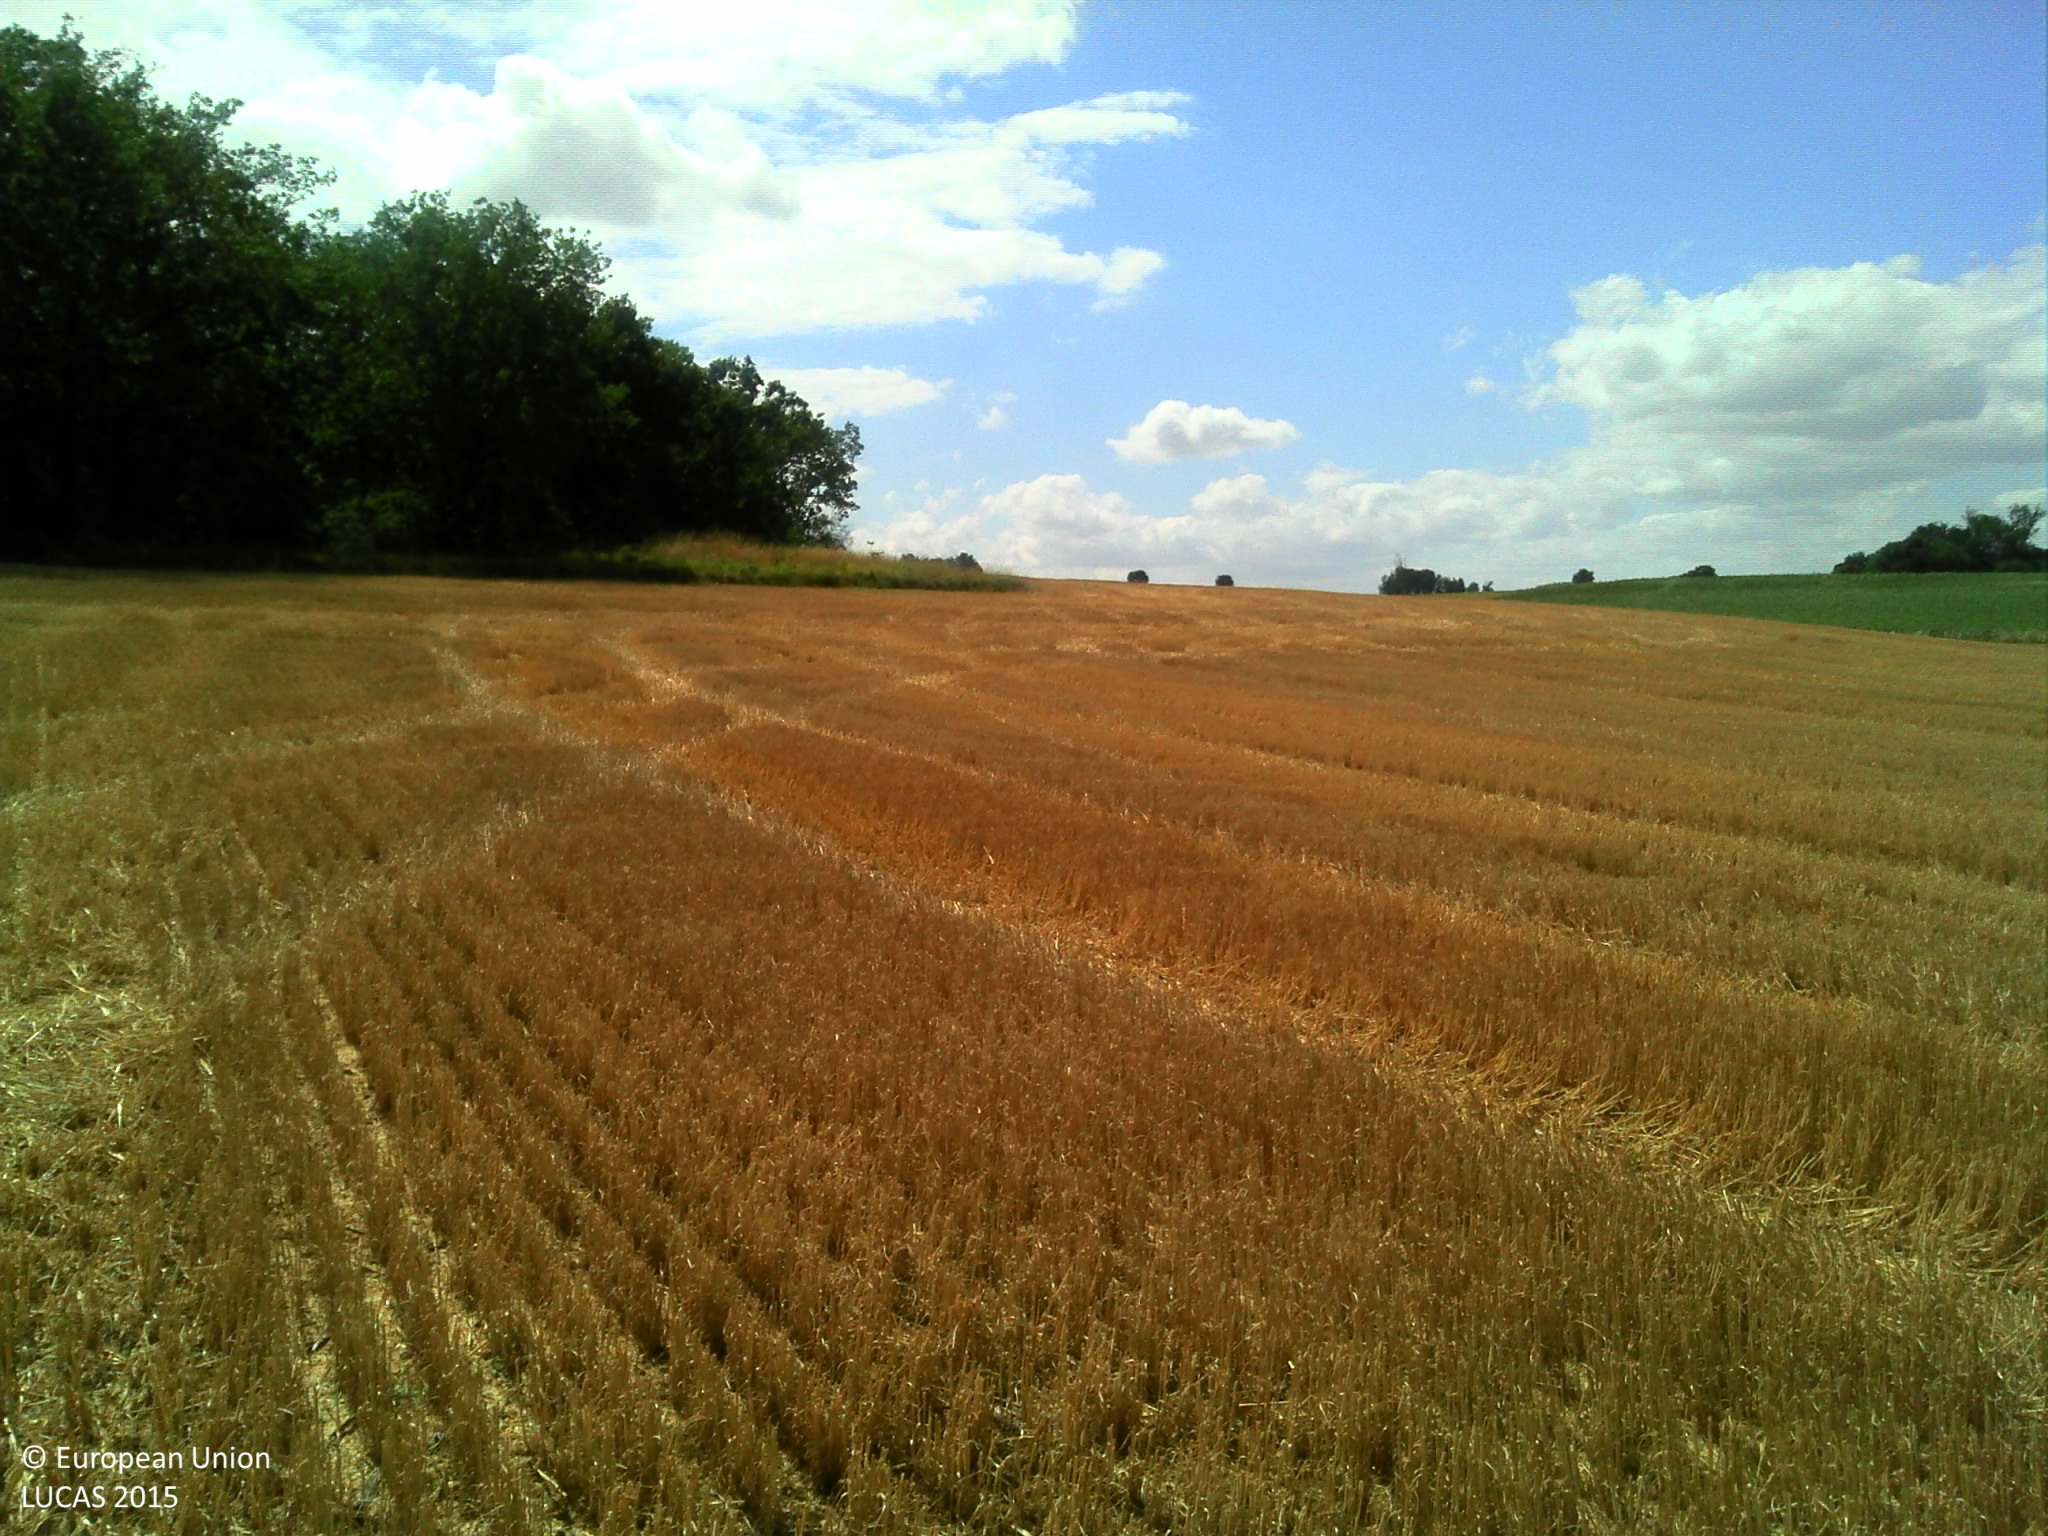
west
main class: Cropland
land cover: Common wheat
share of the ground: > 75 %
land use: Agriculture (excluding fallow land and kitchen gardens)
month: July
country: FR
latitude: 43.7365
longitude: 0.9480
